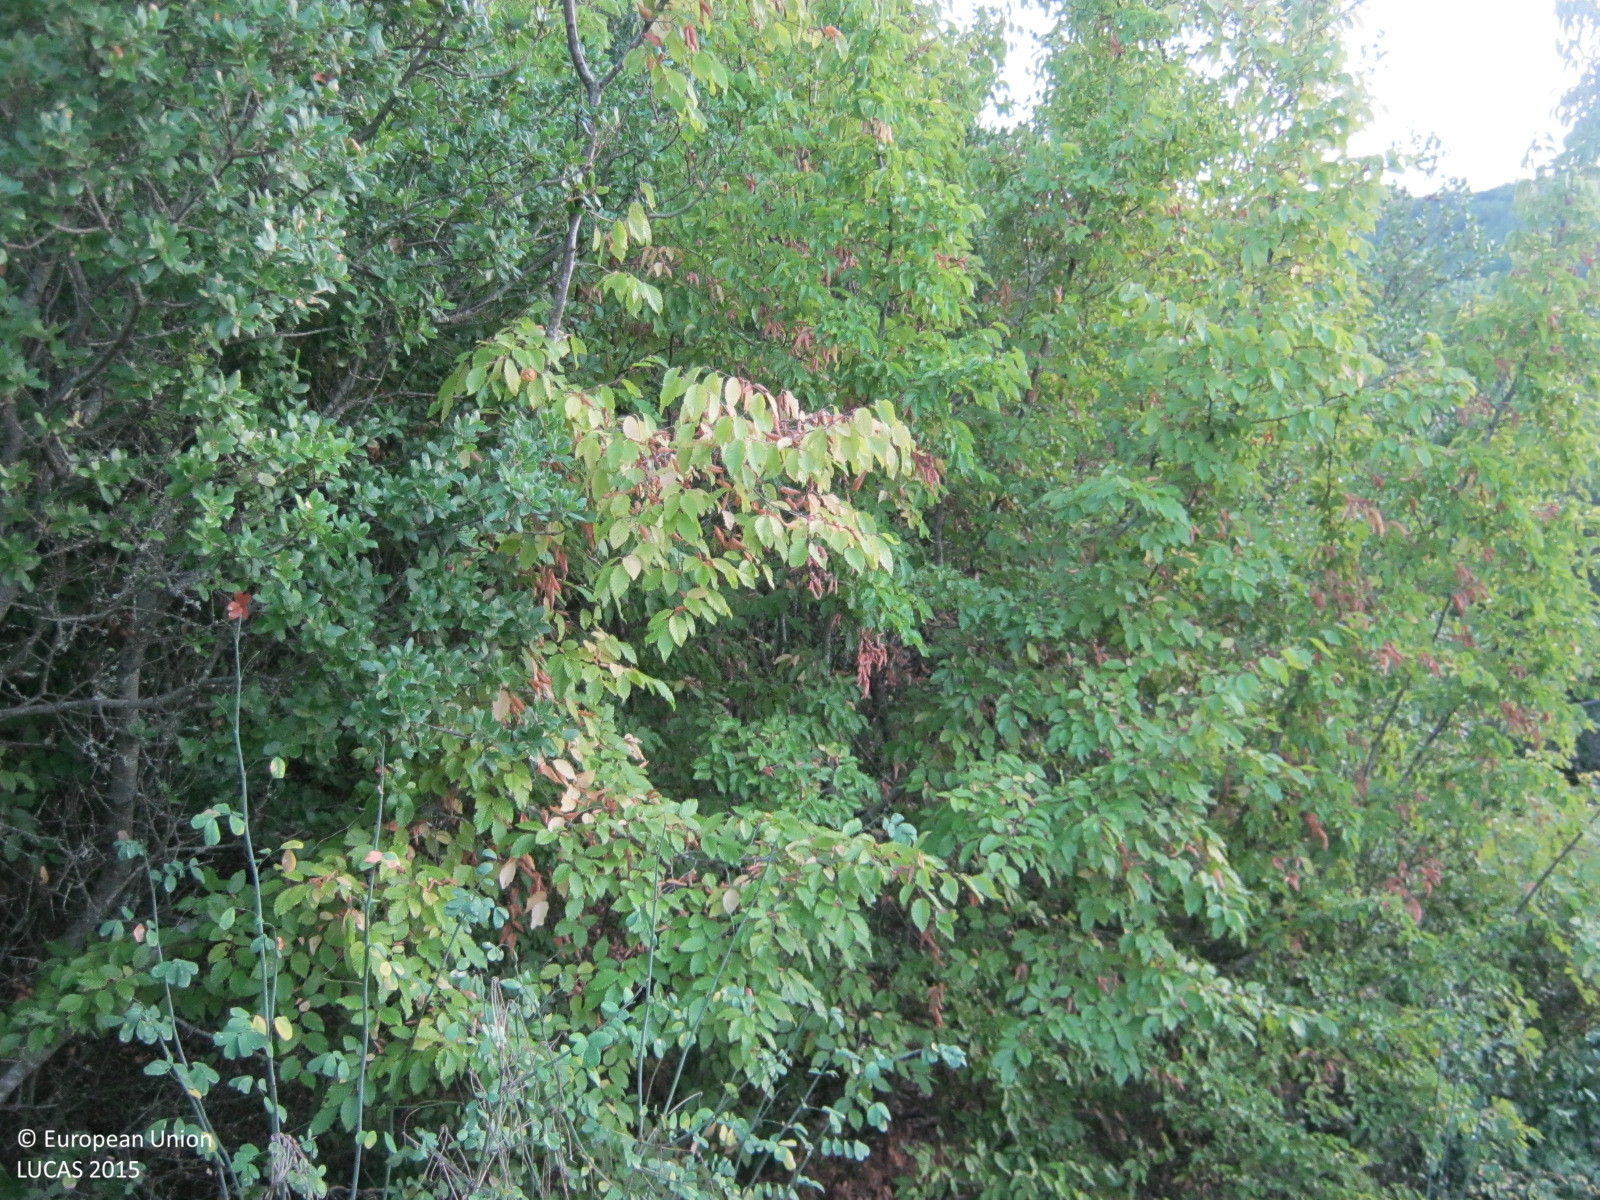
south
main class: Woodland
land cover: Broadleaved woodland
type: thermophilous deciduous forest
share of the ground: > 75 %
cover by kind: broadleaved forest trees 90 %, coniferous forest trees 5 %, shrubs 5 %
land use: Forestry
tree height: > 5 m
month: September
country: GR
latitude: 40.5029
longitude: 23.3567
